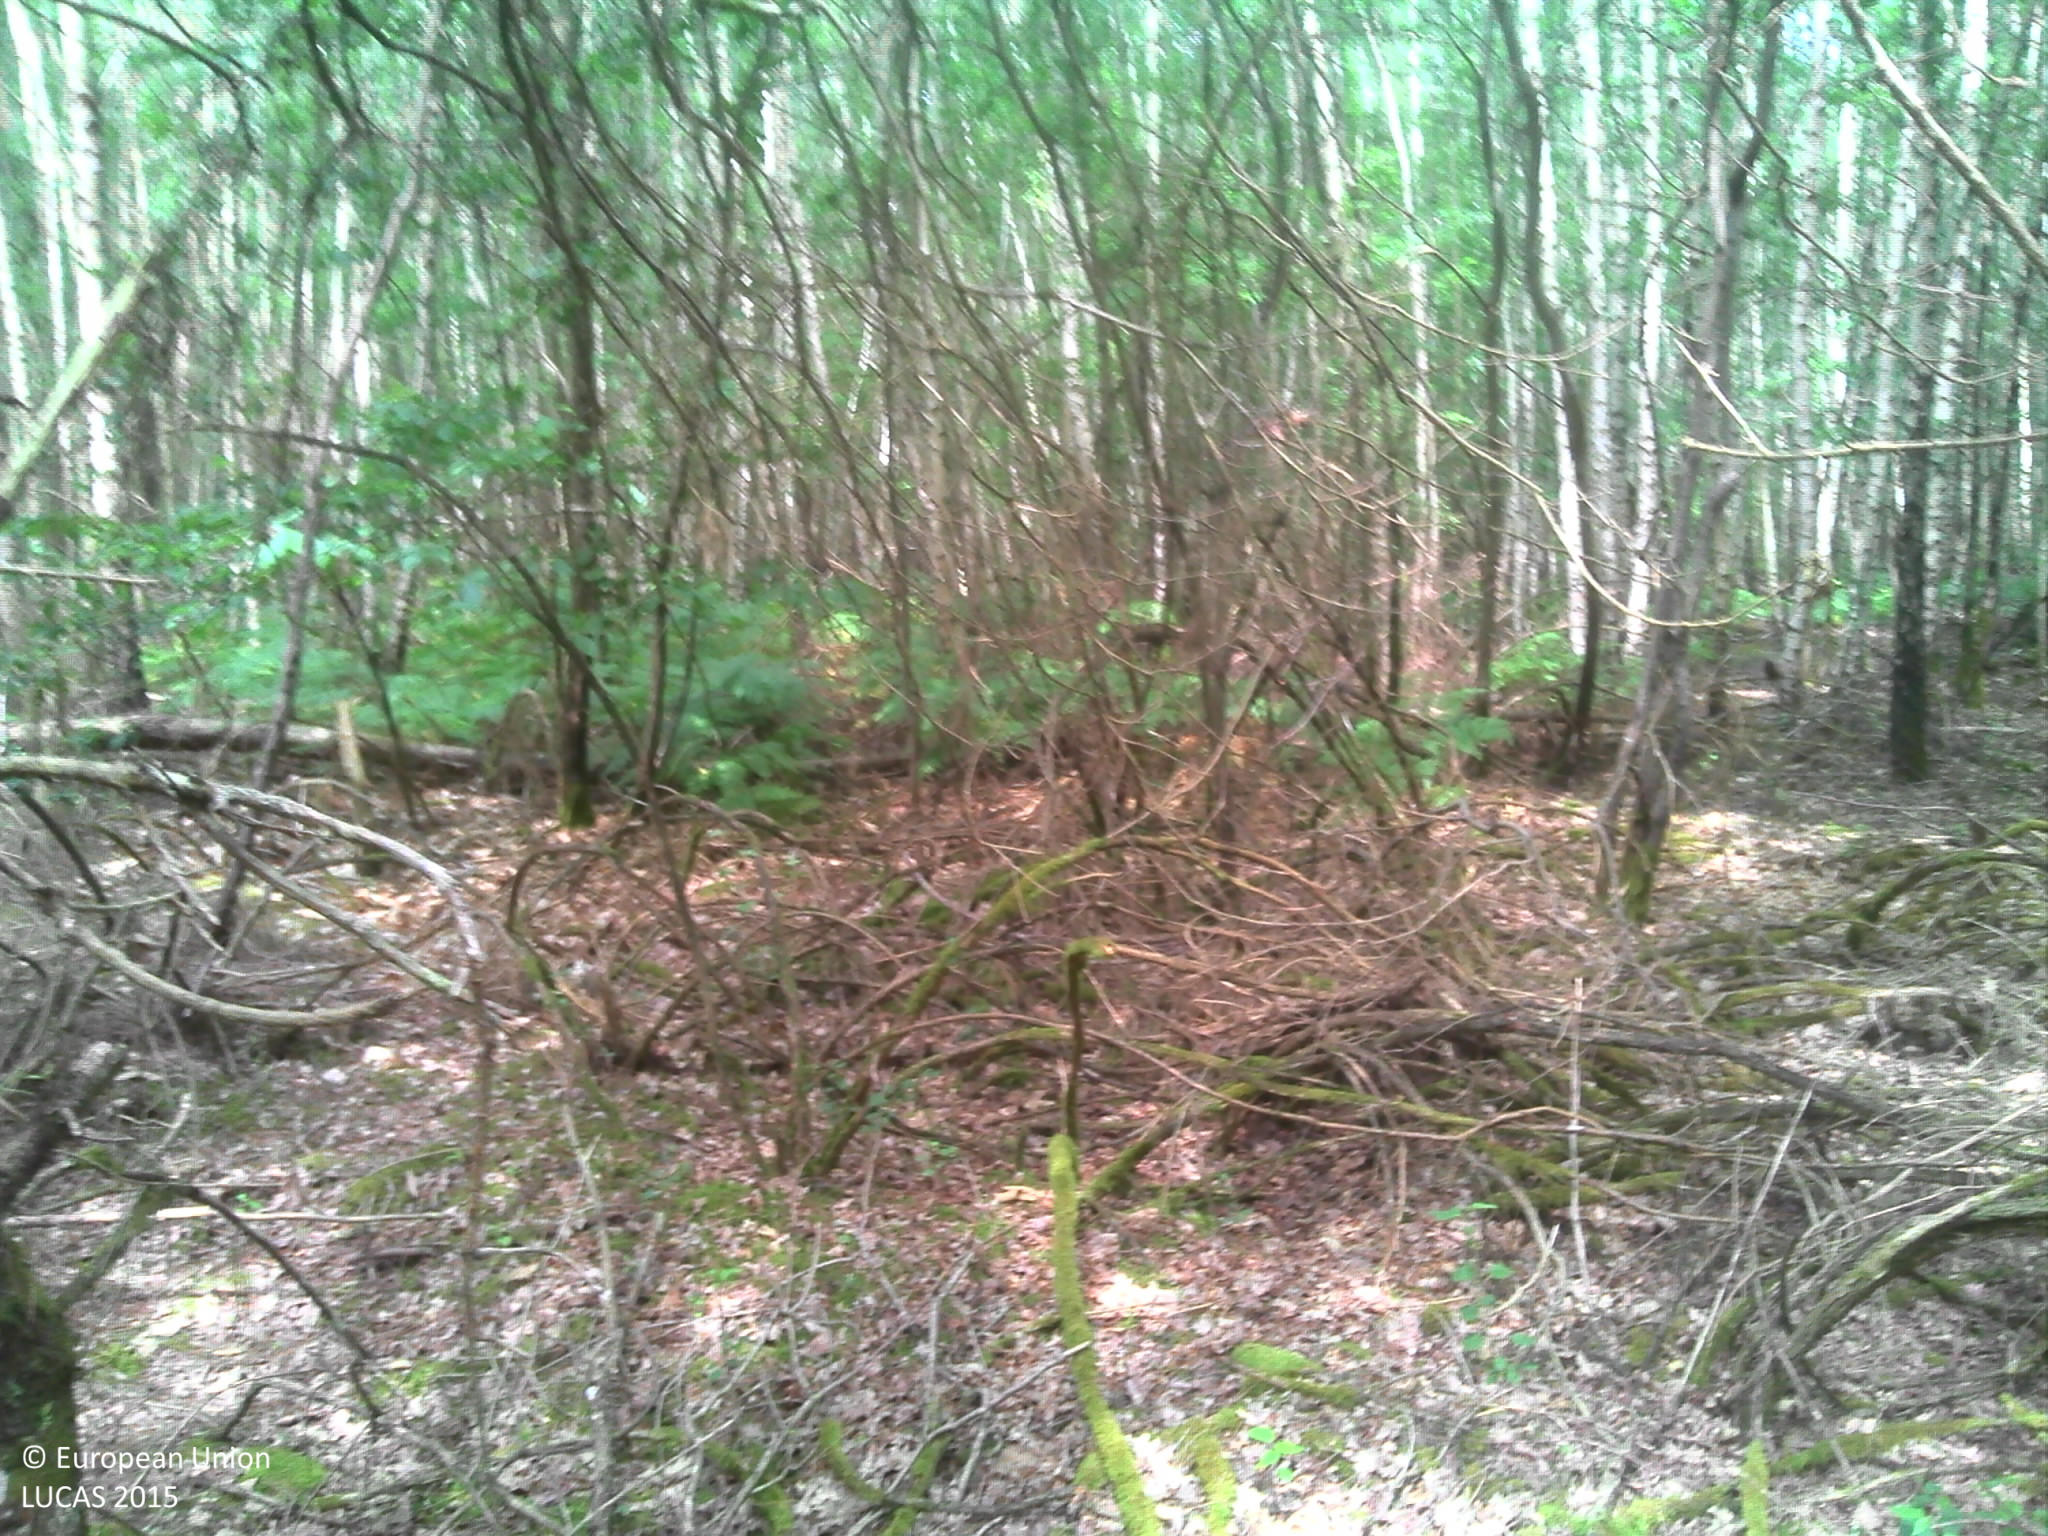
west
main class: Woodland
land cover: Pine dominated mixed woodland
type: thermophilous deciduous forest
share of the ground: > 75 %
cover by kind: unconsolidated bare surface 30 %, herbaceous plants 20 %, lichens and mosses 20 %, coniferous forest trees 15 %, broadleaved forest trees 15 %
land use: Forestry
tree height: > 5 m
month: June
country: FR
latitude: 47.3417
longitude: 1.3694
